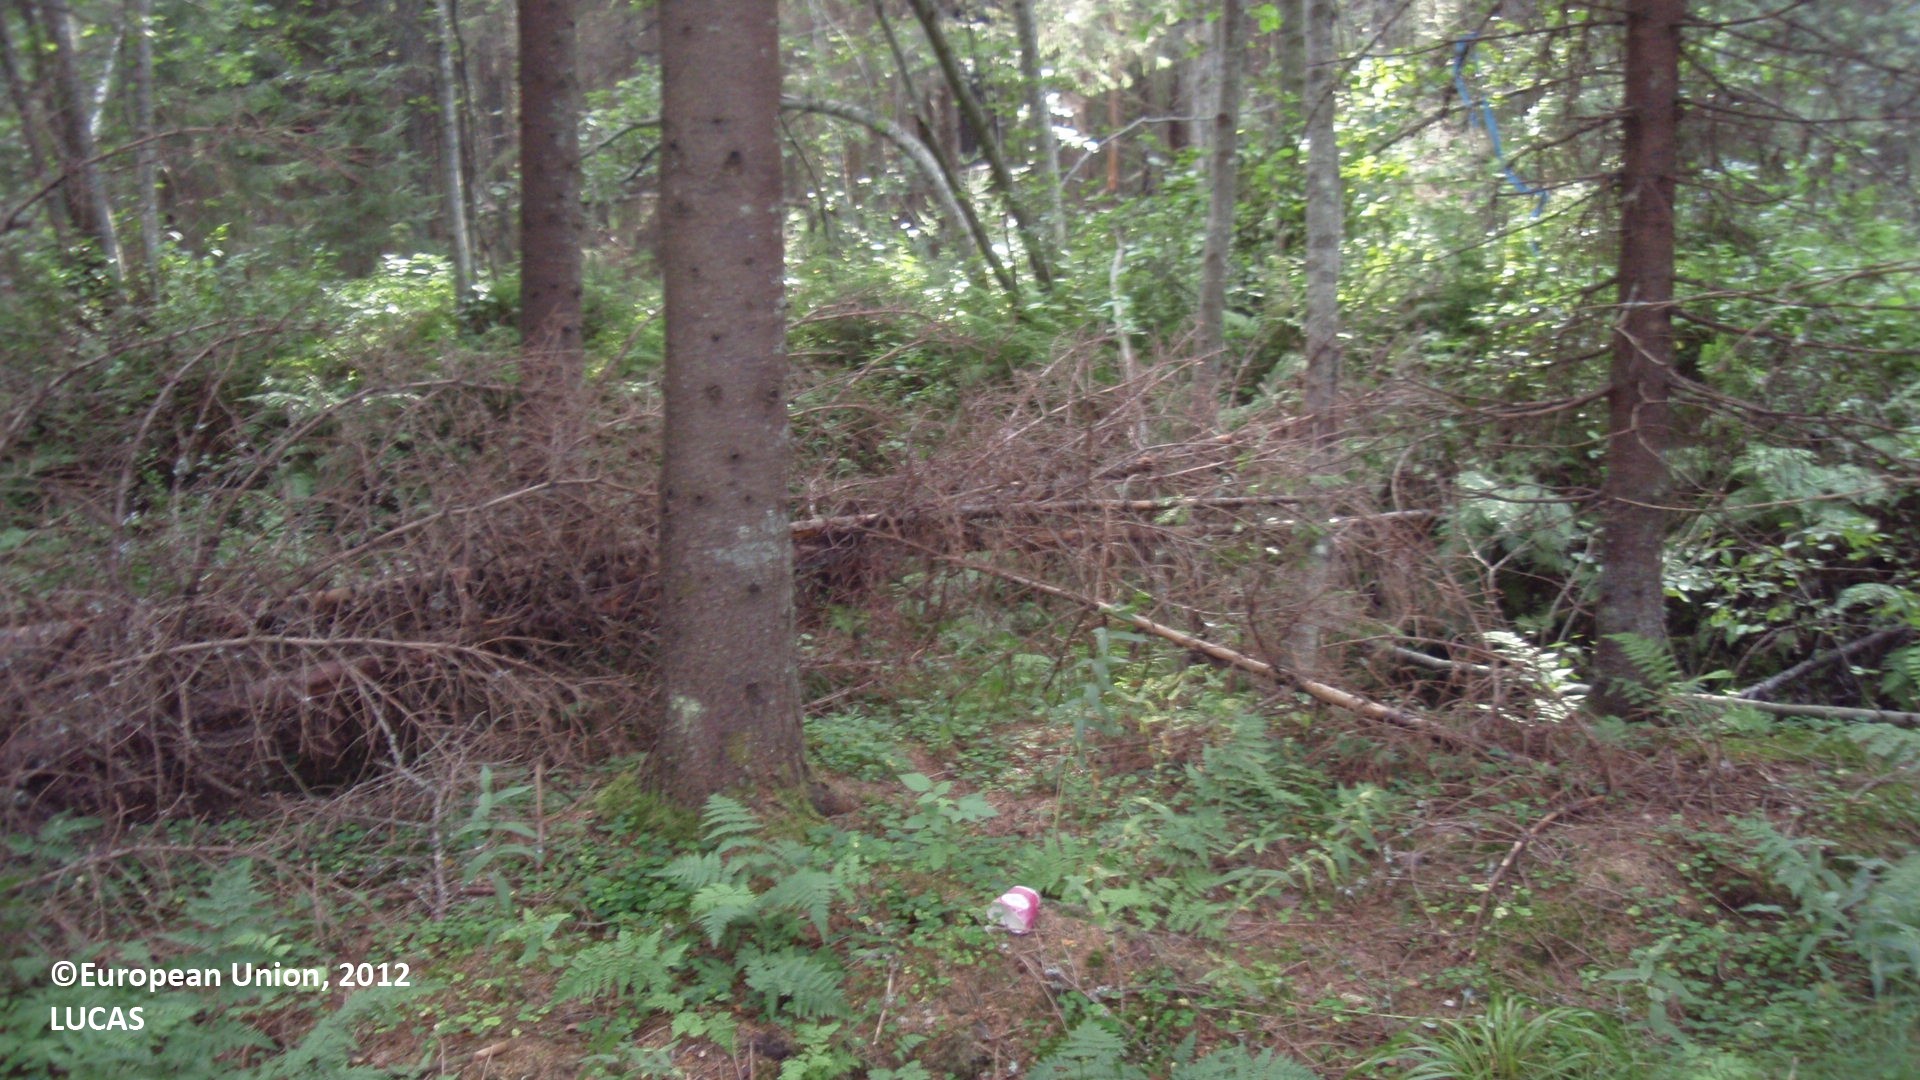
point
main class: Woodland
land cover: Spruce dominated coniferous woodland
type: boreal forest
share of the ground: 50 - 75 %
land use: Forestry
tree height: > 5 m
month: August
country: FI
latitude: 60.7726
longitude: 27.2320
